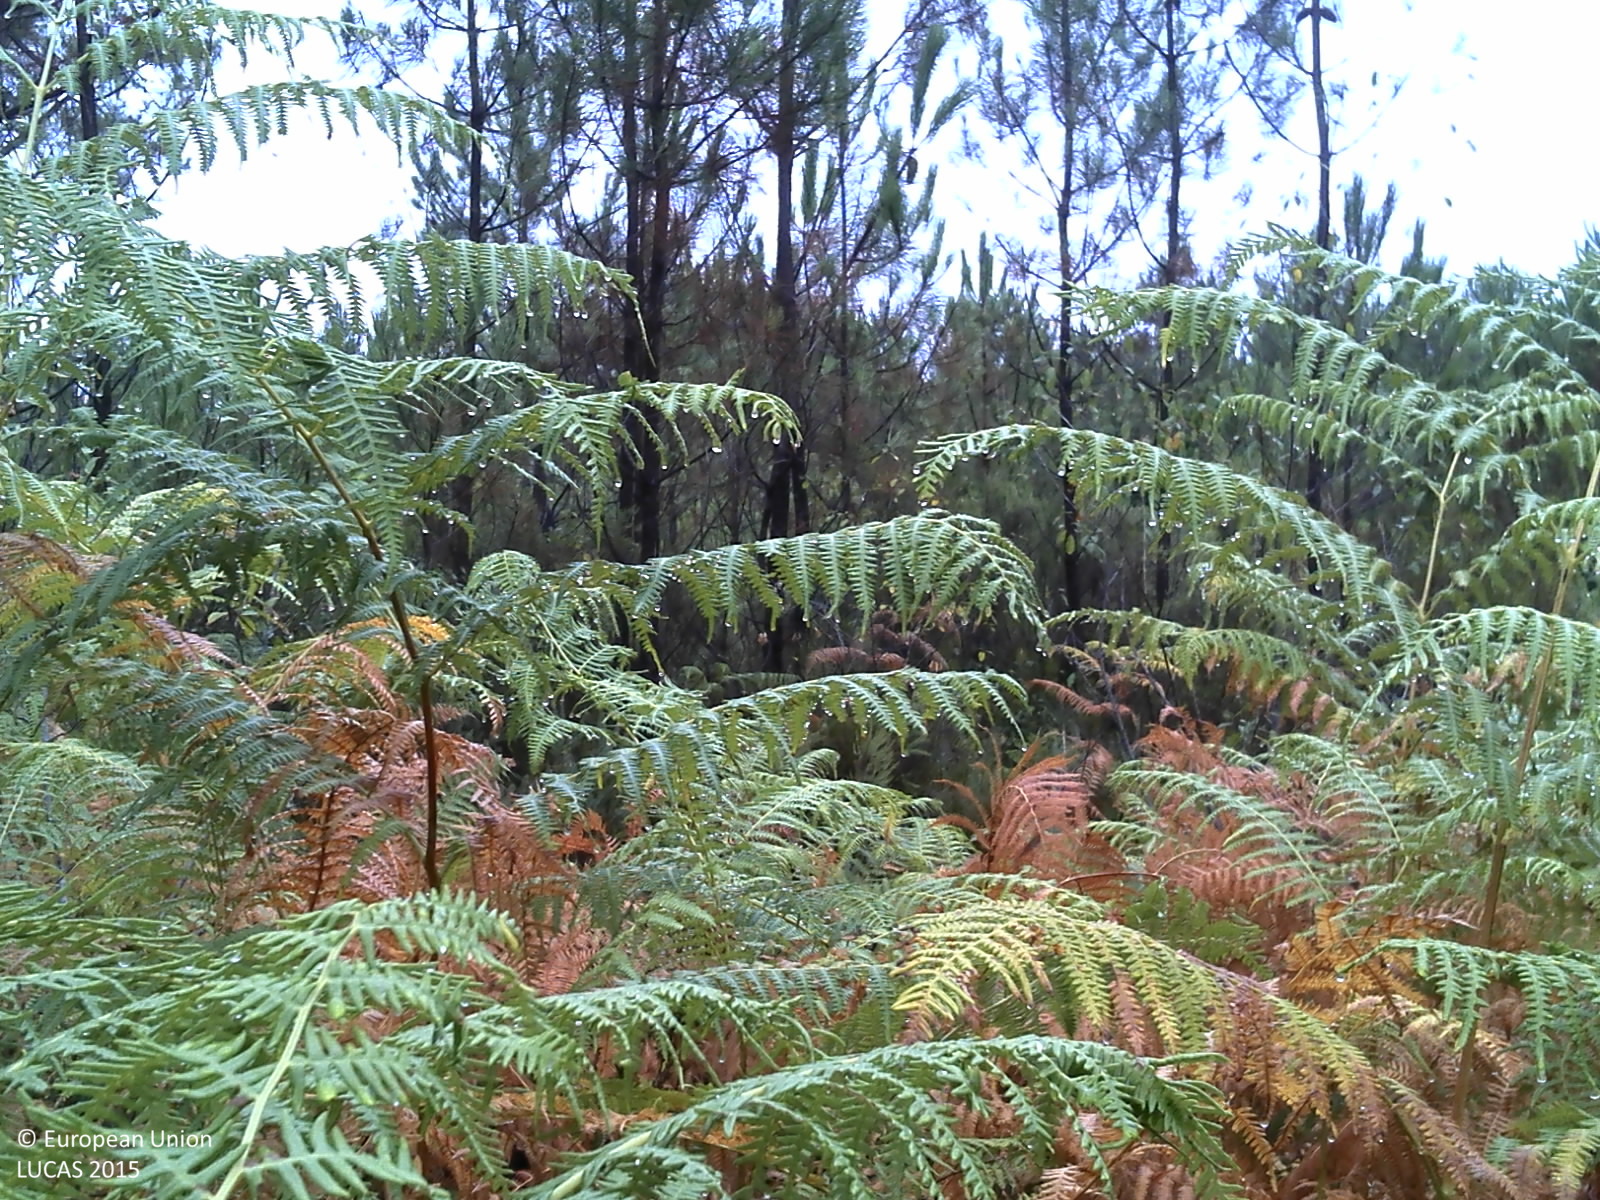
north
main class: Woodland
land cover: Pine dominated coniferous woodland
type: coniferous forest of the mediterranean region
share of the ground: > 75 %
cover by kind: coniferous forest trees 60 %, shrubs 30 %, herbaceous plants 5 %, lichens and mosses 5 %
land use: Forestry
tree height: < 5 m
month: August
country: FR
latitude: 44.6011
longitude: -0.9947
